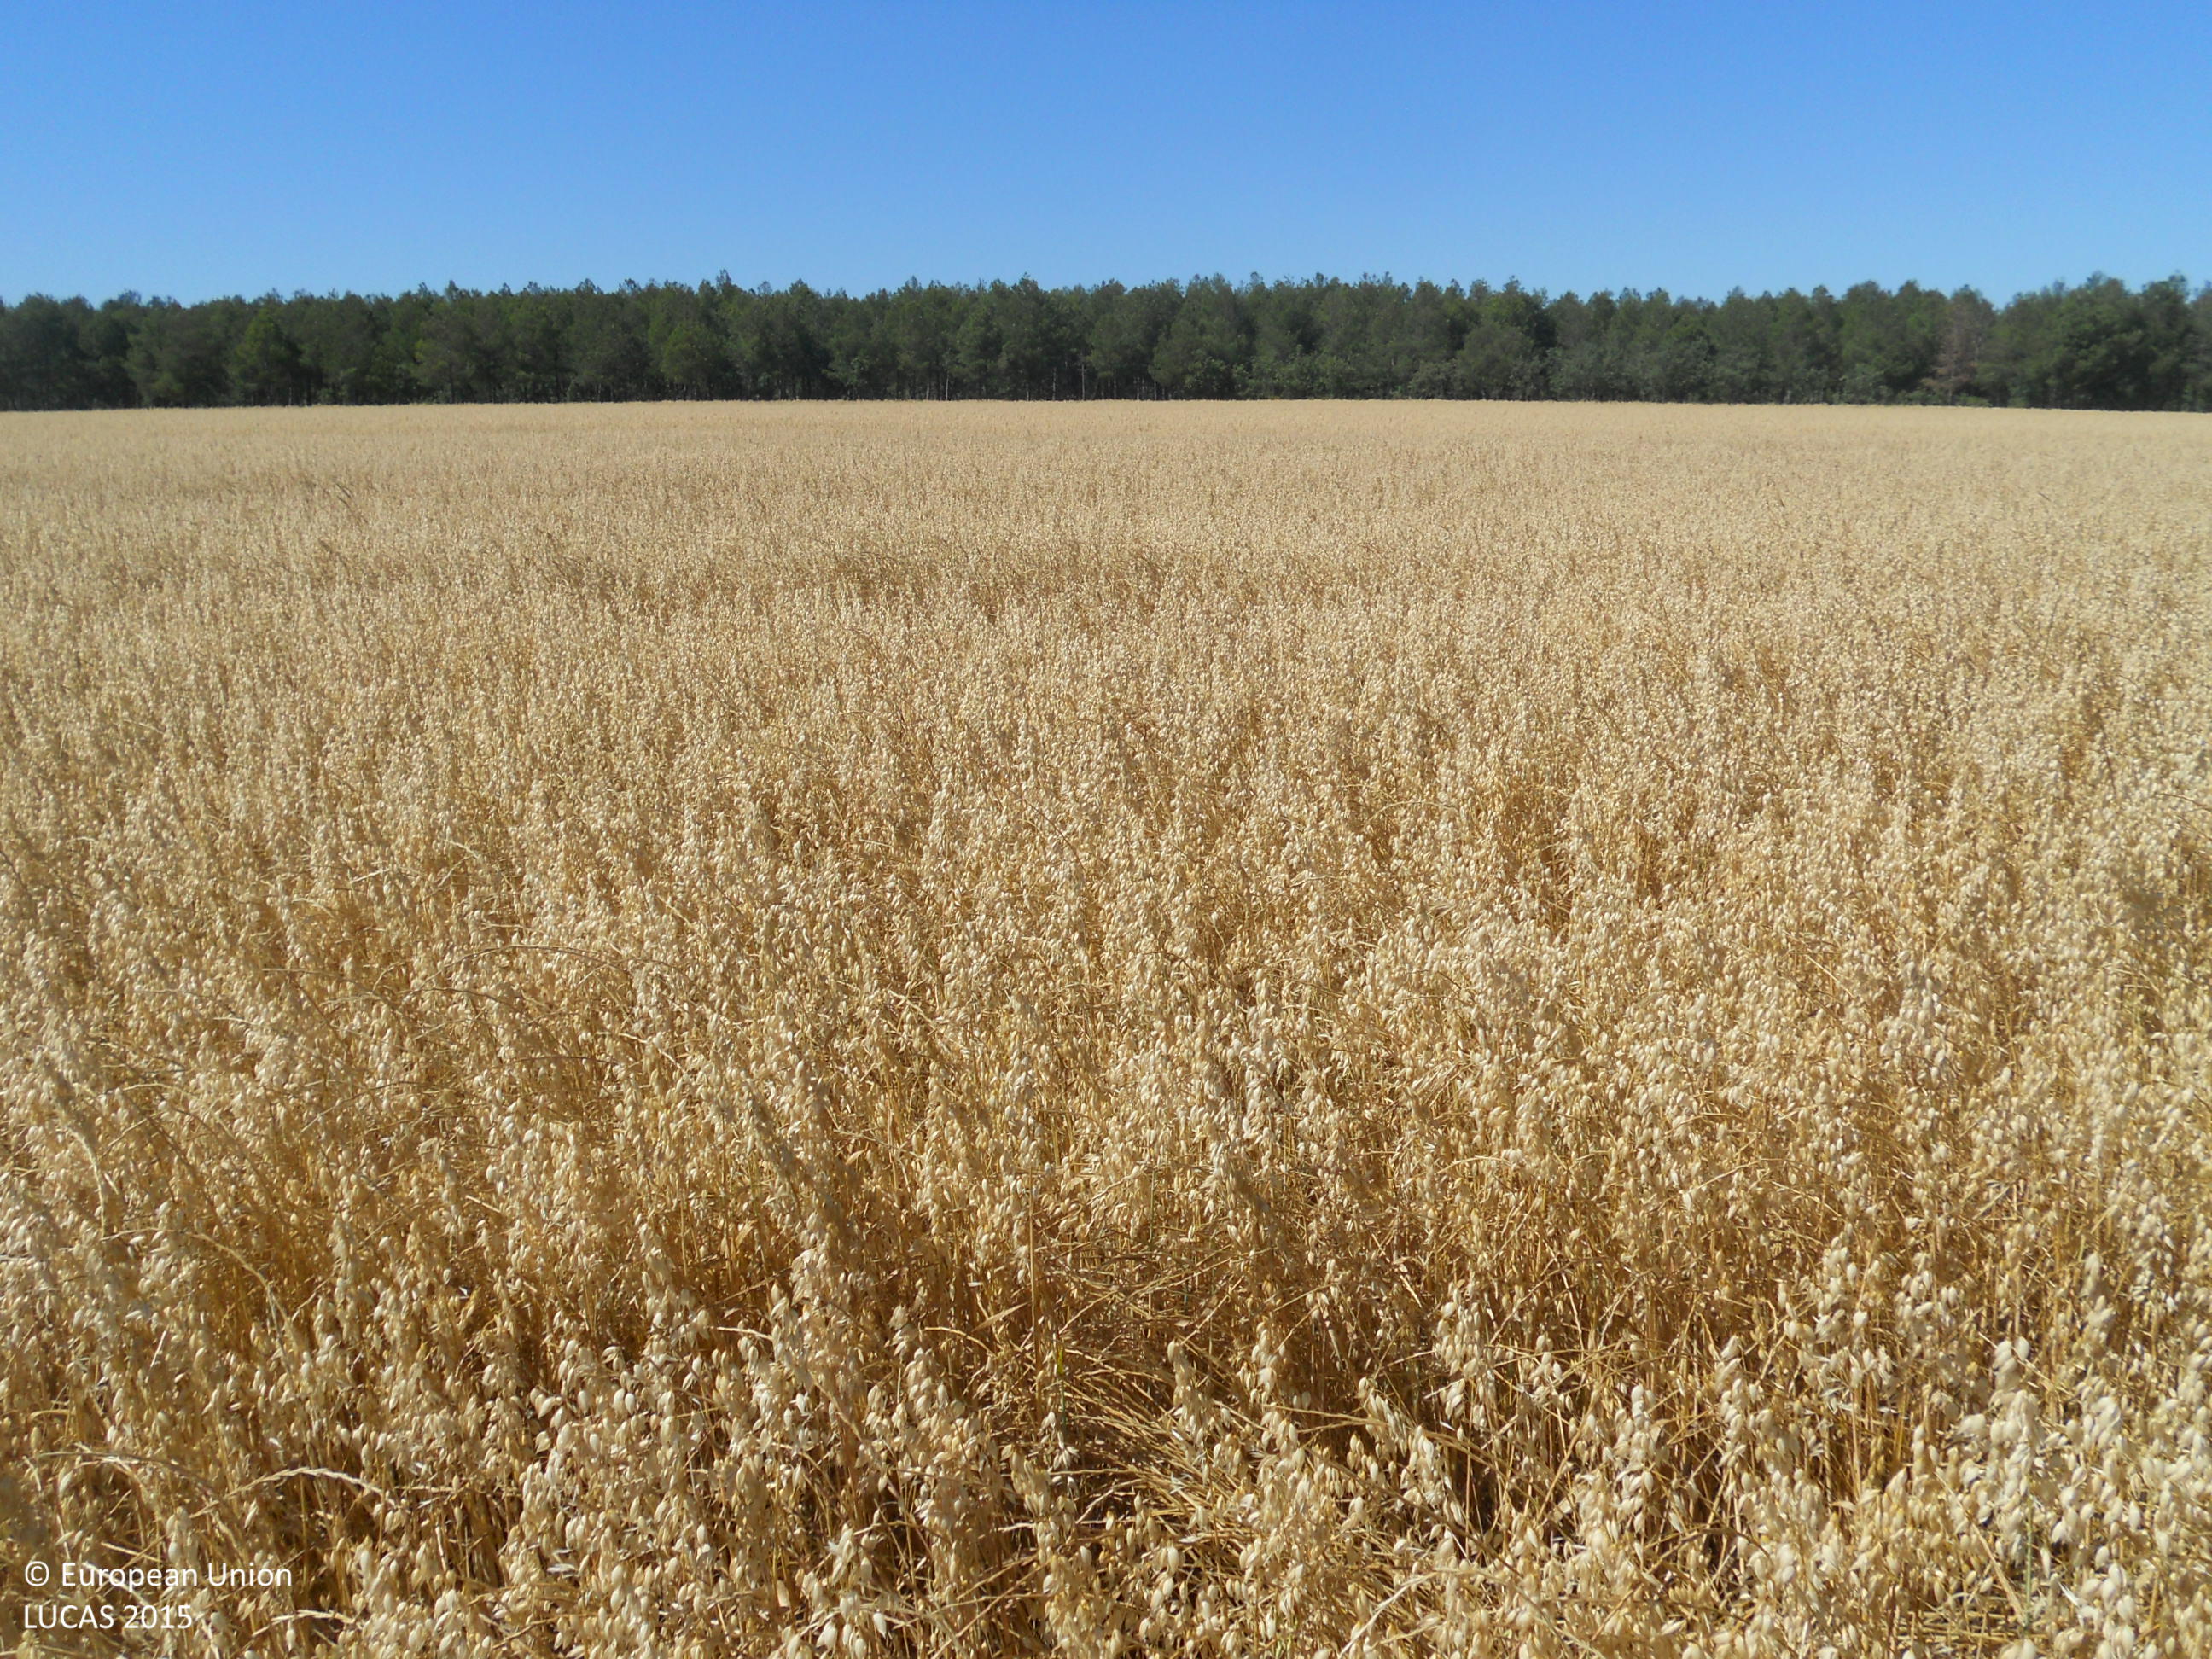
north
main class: Cropland
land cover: Oats
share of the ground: > 75 %
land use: Agriculture (excluding fallow land and kitchen gardens)
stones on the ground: > 50 %
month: June
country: ES
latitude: 42.4110
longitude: -4.8692
